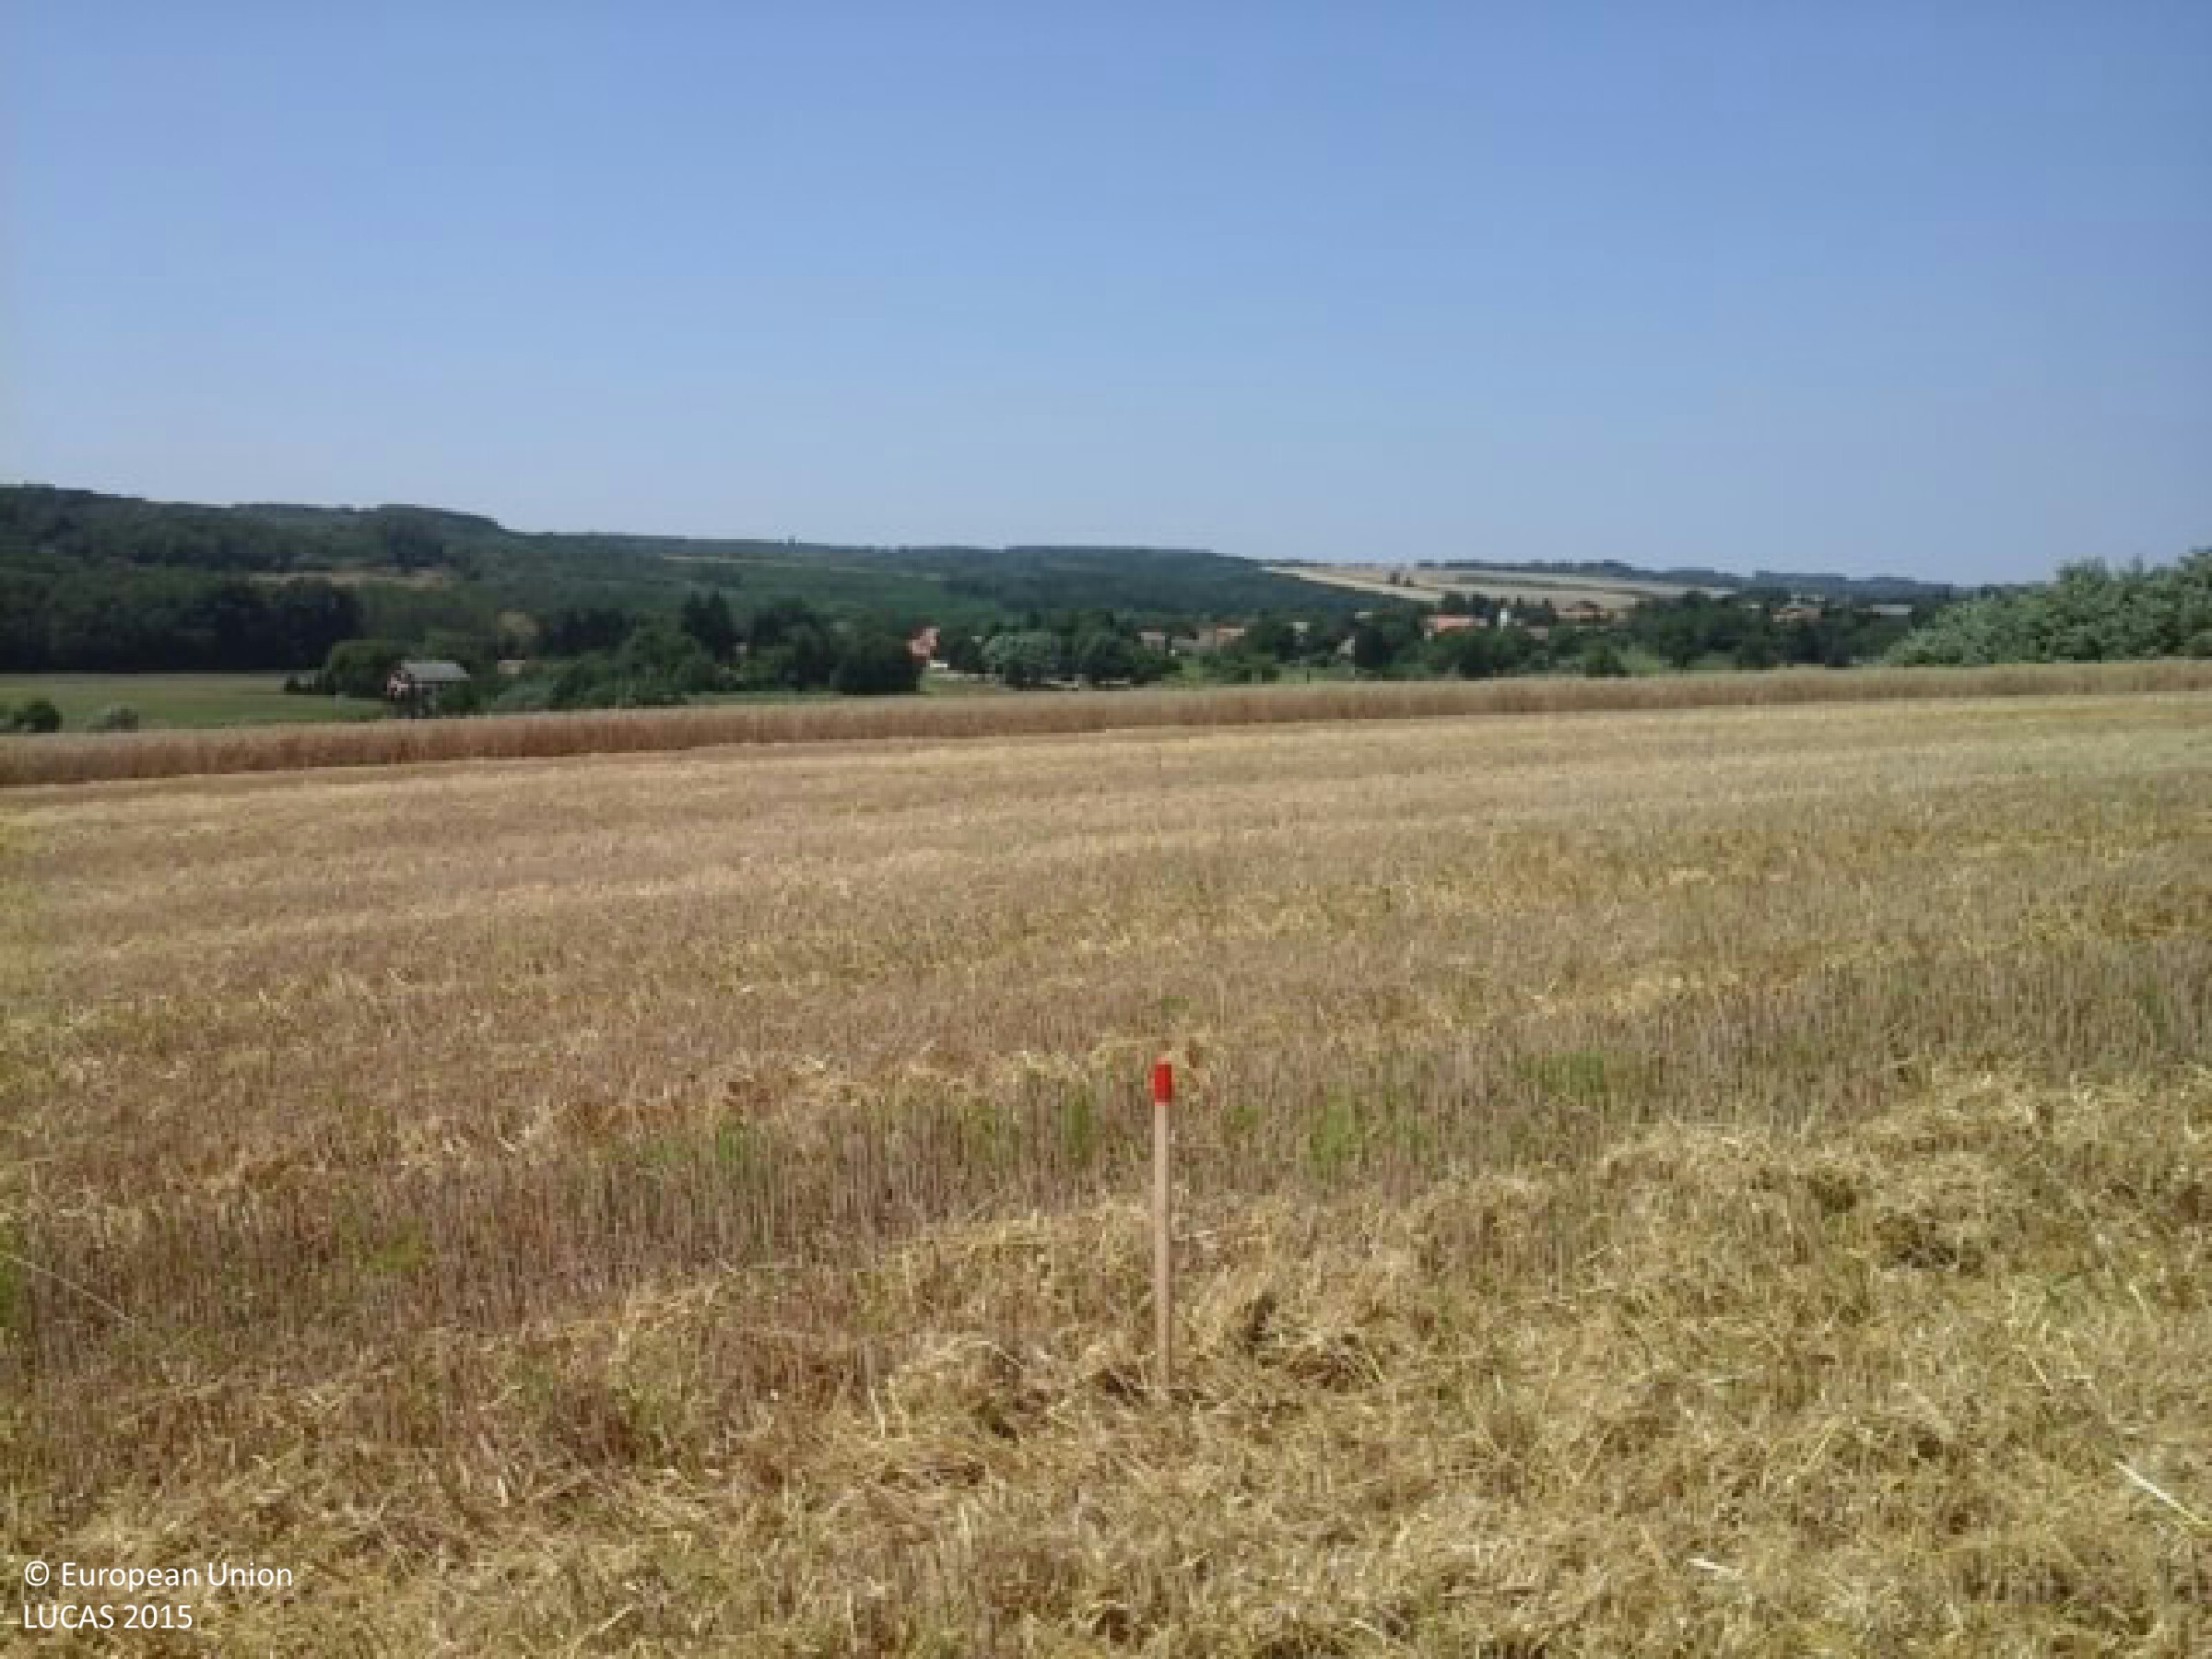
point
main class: Cropland
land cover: Common wheat
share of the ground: > 75 %
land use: Agriculture (excluding fallow land and kitchen gardens)
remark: Harvested field
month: July
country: HU
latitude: 46.2829
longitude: 17.0238
